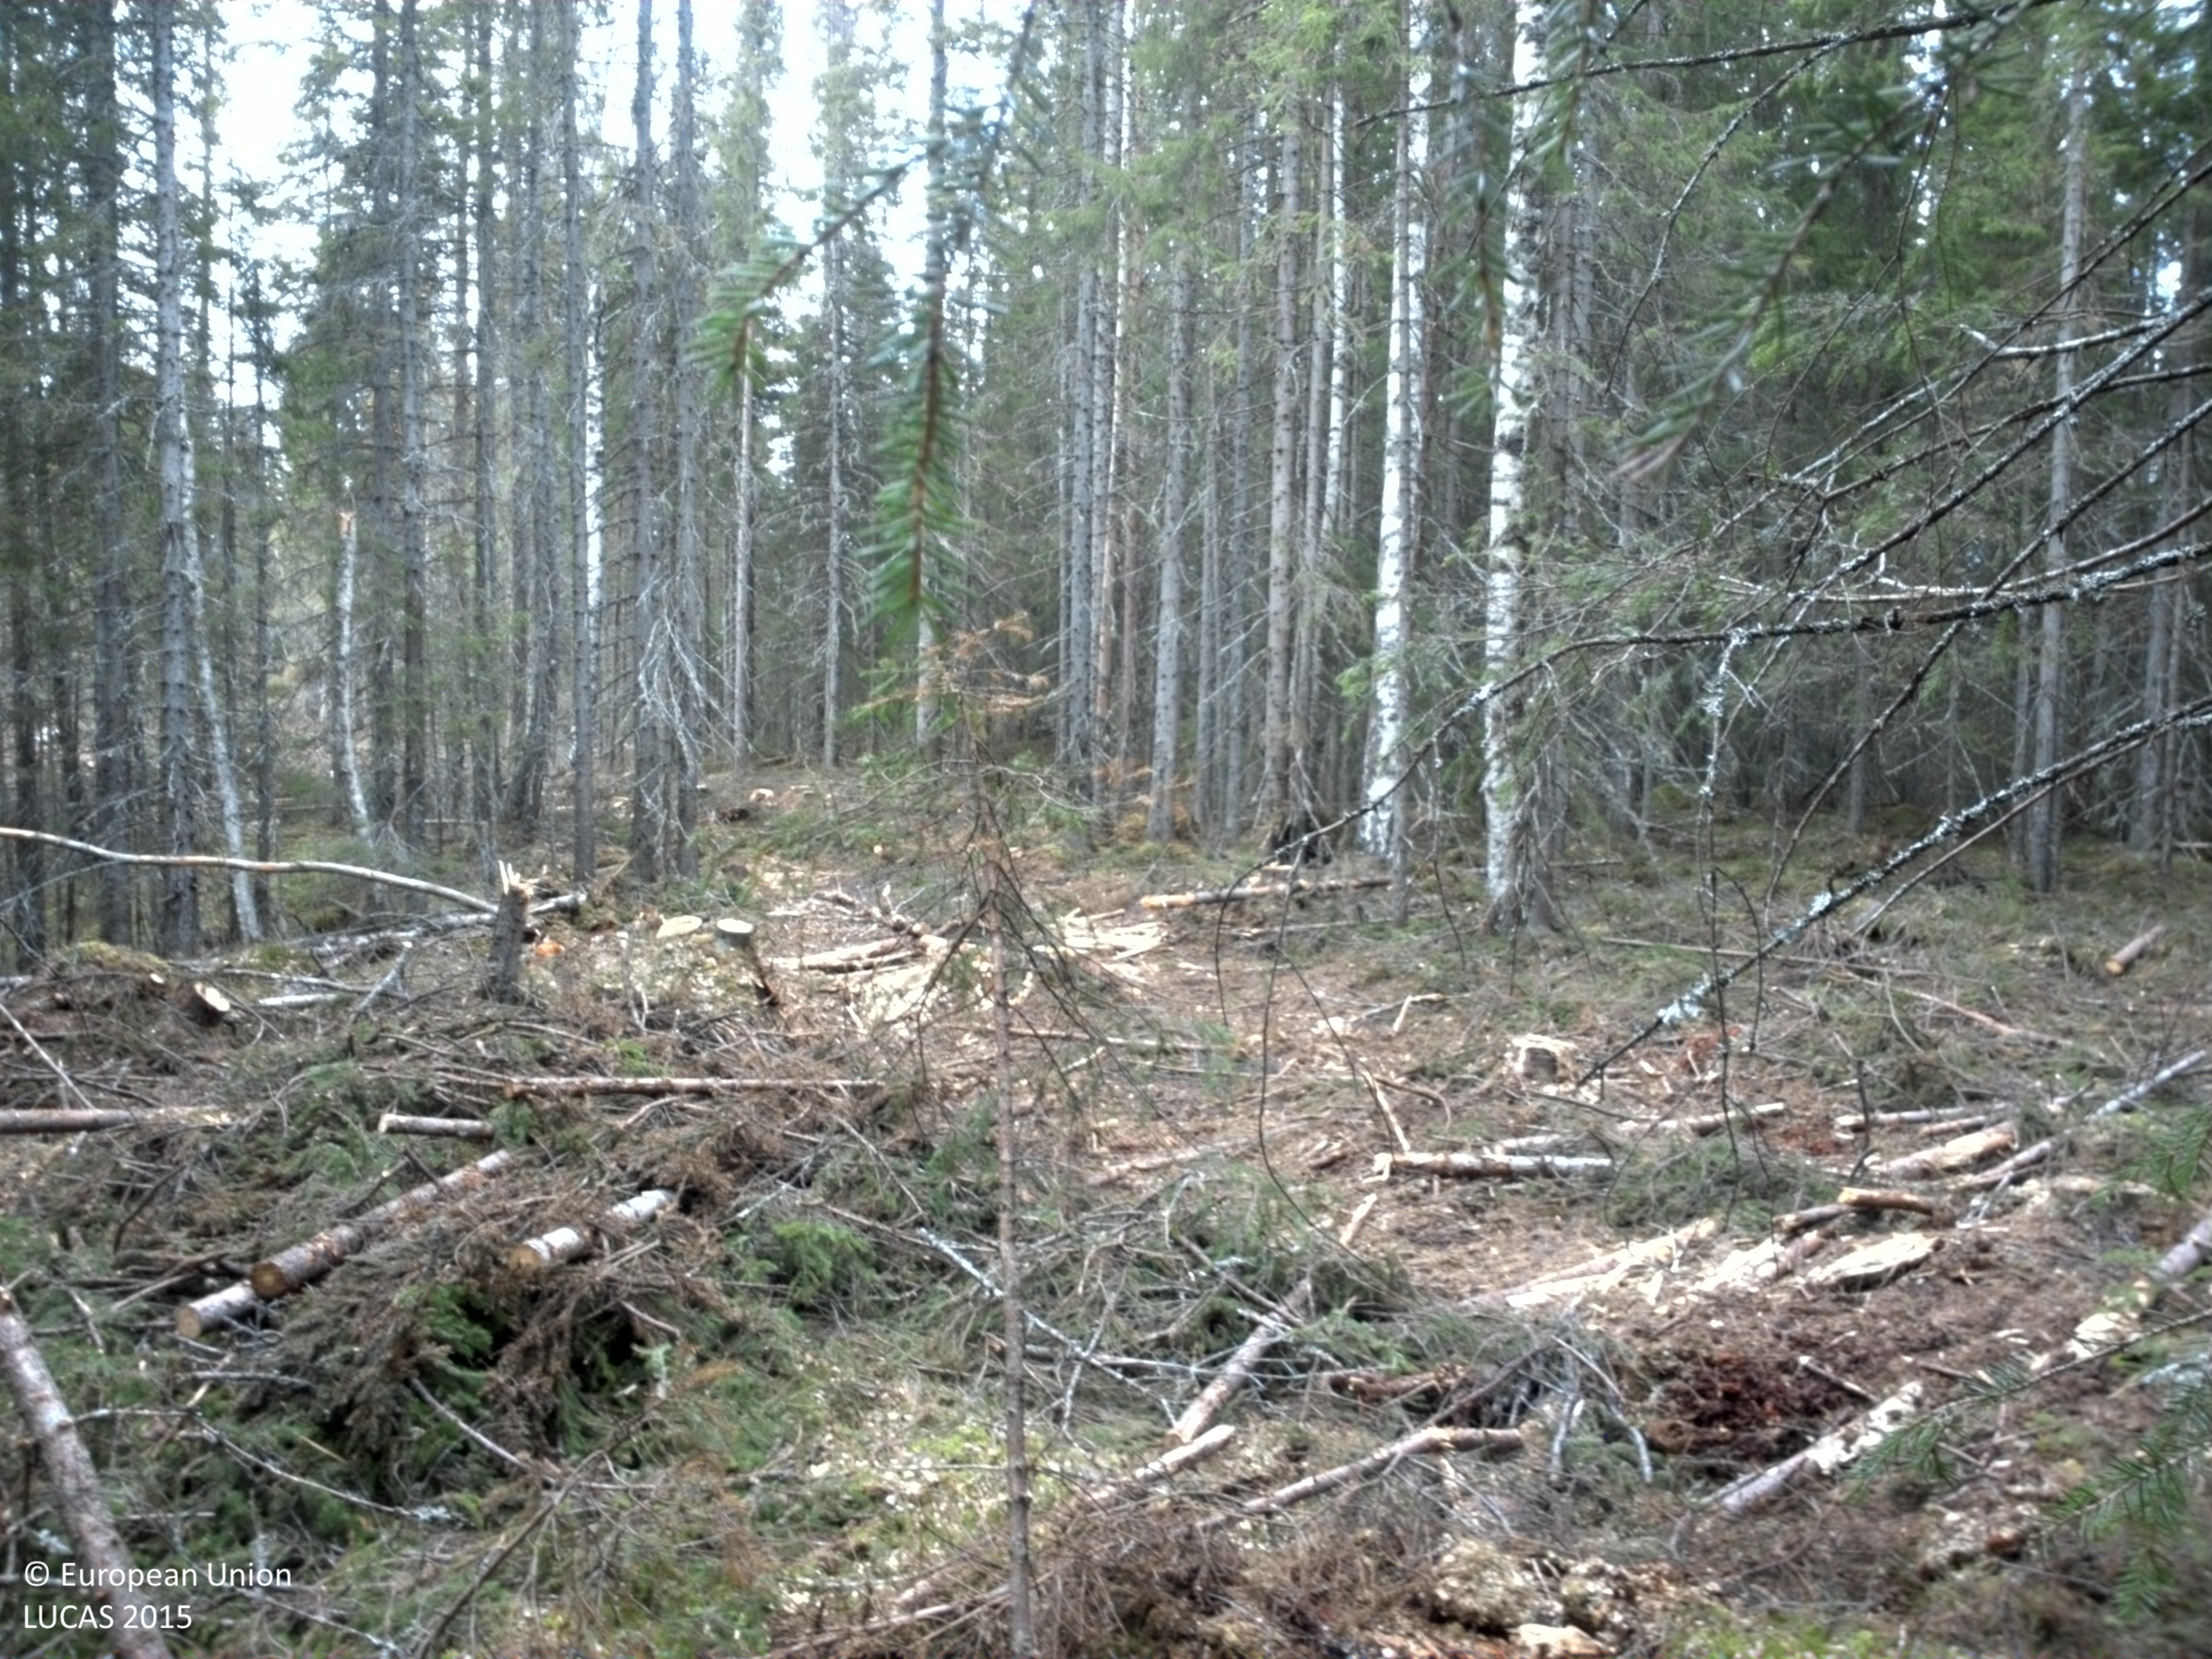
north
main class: Woodland
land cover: Spruce dominated coniferous woodland
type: boreal forest
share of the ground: > 75 %
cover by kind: coniferous forest trees 85 %, lichens and mosses 10 %, broadleaved forest trees 5 %
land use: Forestry
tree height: > 5 m
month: May
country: SE
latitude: 62.6585
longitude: 14.9177
